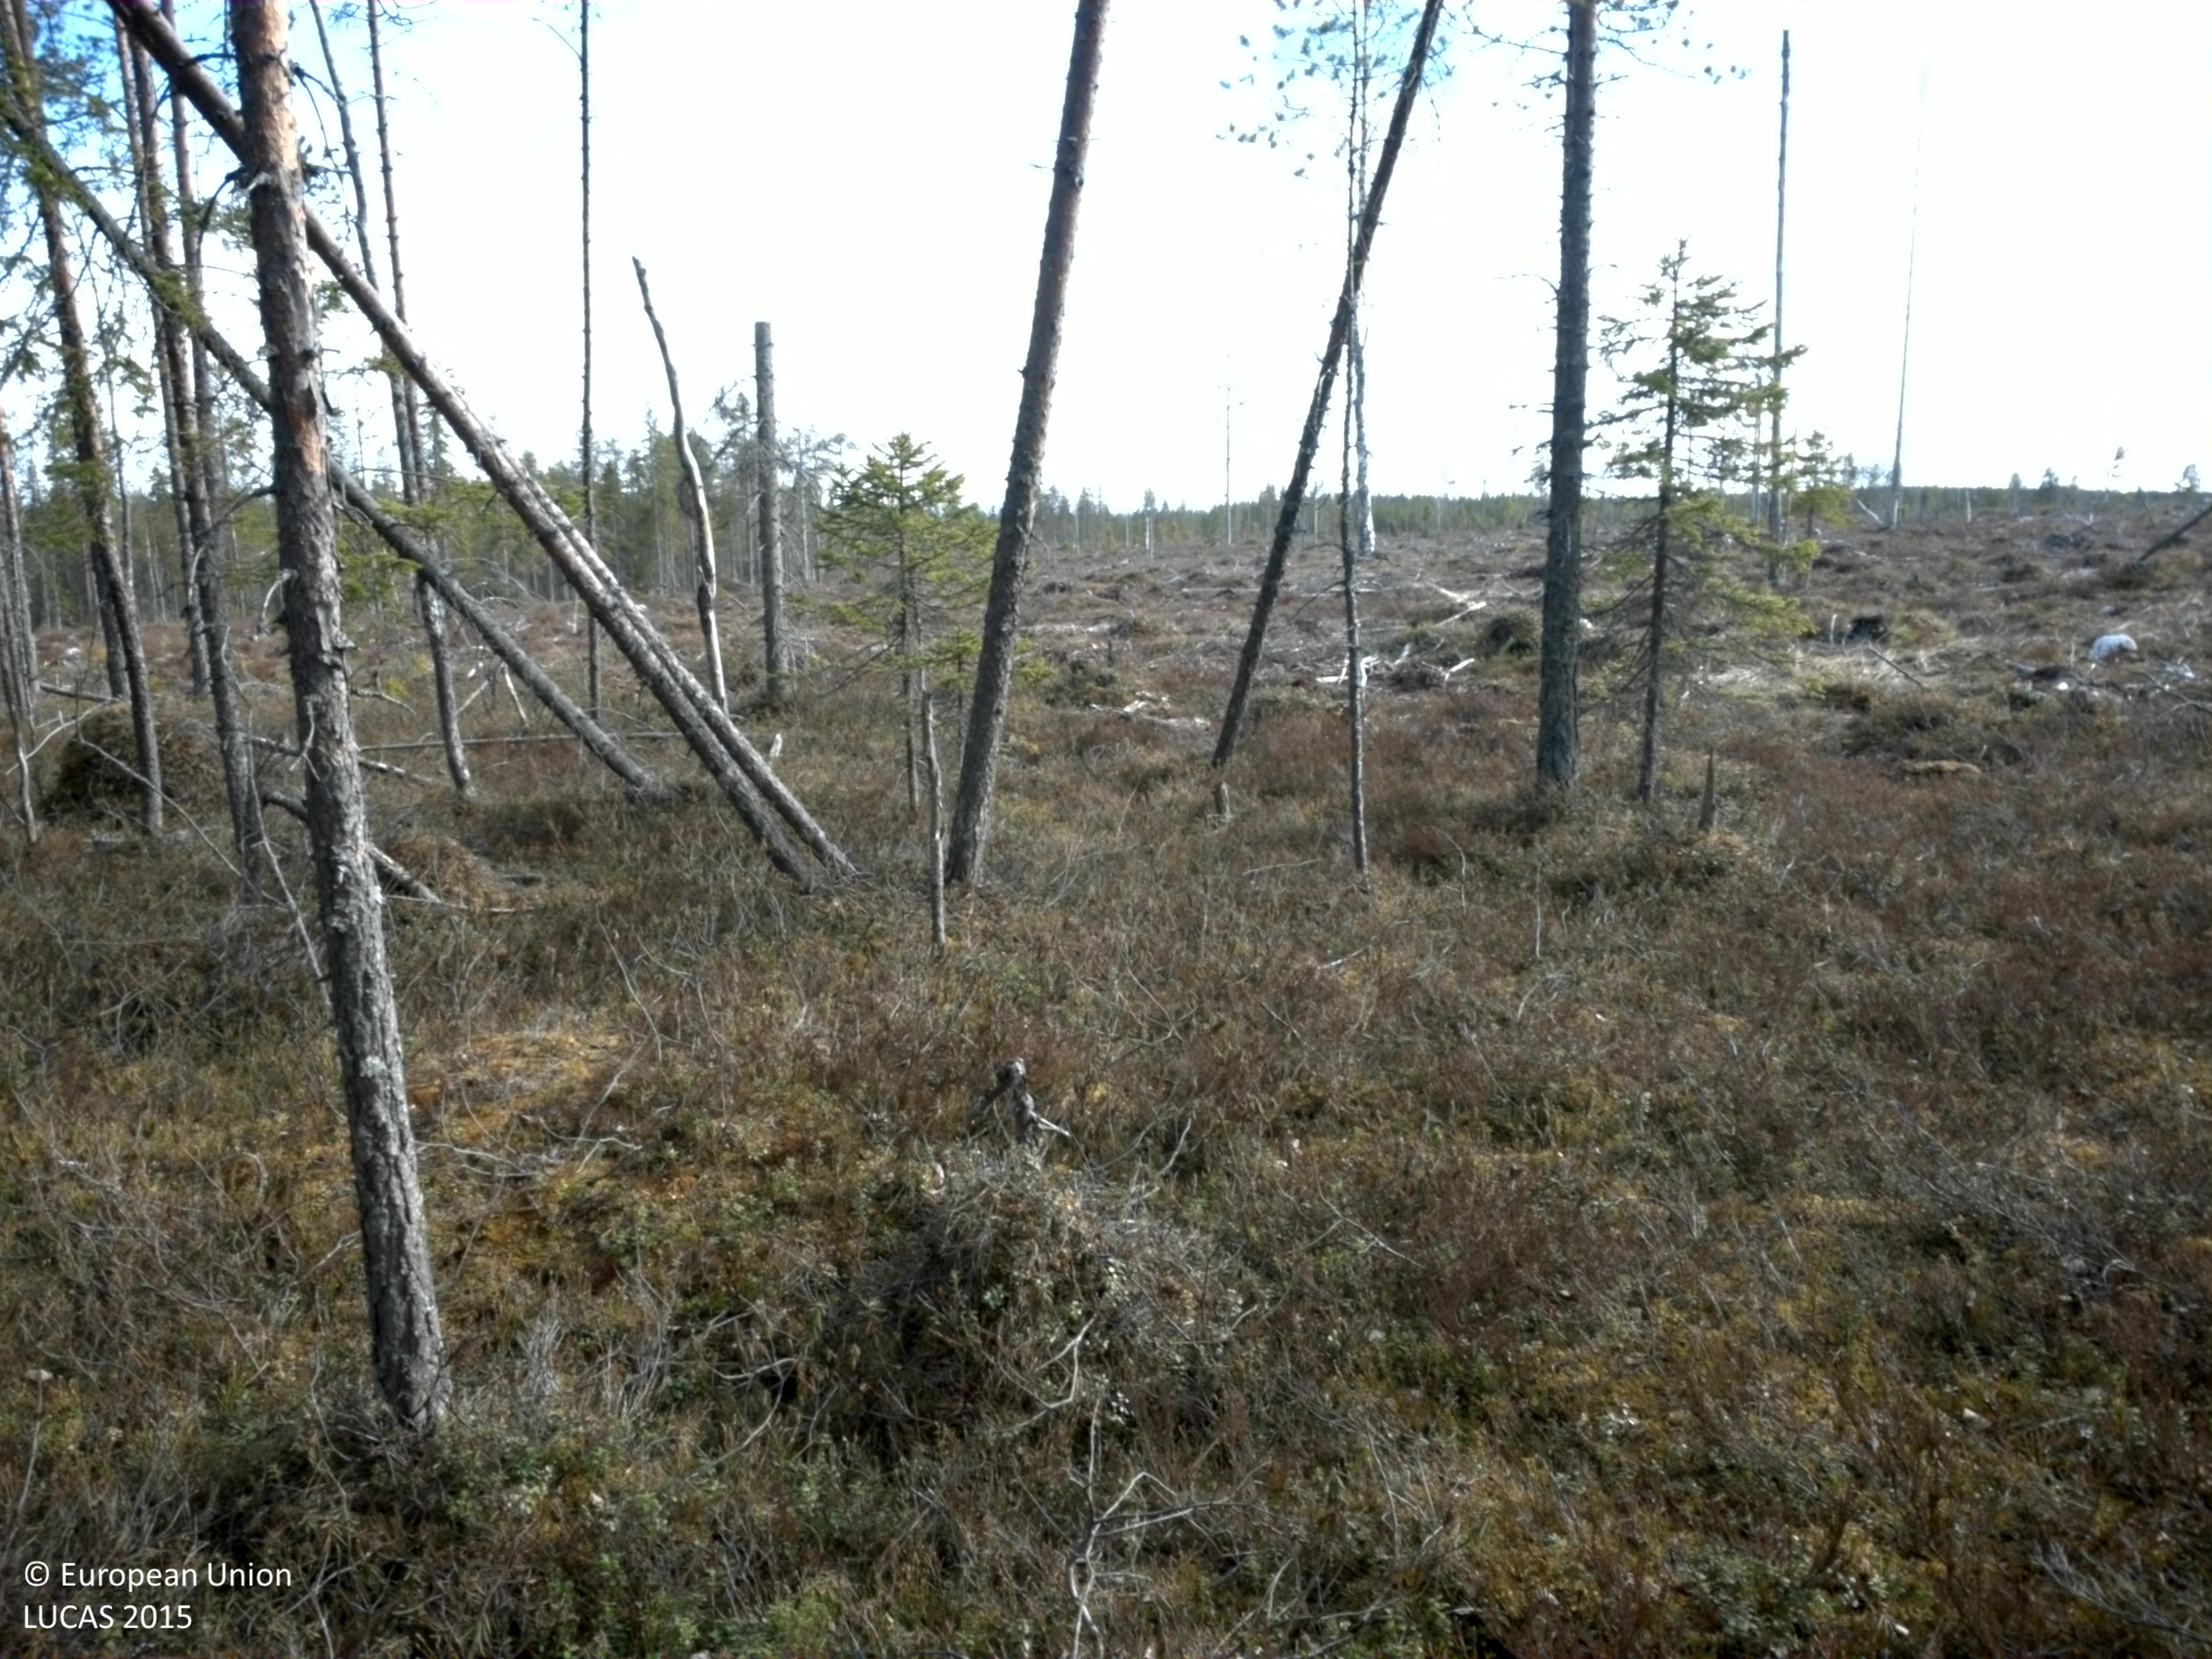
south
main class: Woodland
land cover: Pine dominated coniferous woodland
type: boreal forest
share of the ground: > 75 %
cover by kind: coniferous forest trees 80 %, shrubs 20 %
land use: Forestry
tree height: > 5 m
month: May
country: SE
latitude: 65.9720
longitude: 23.7061
